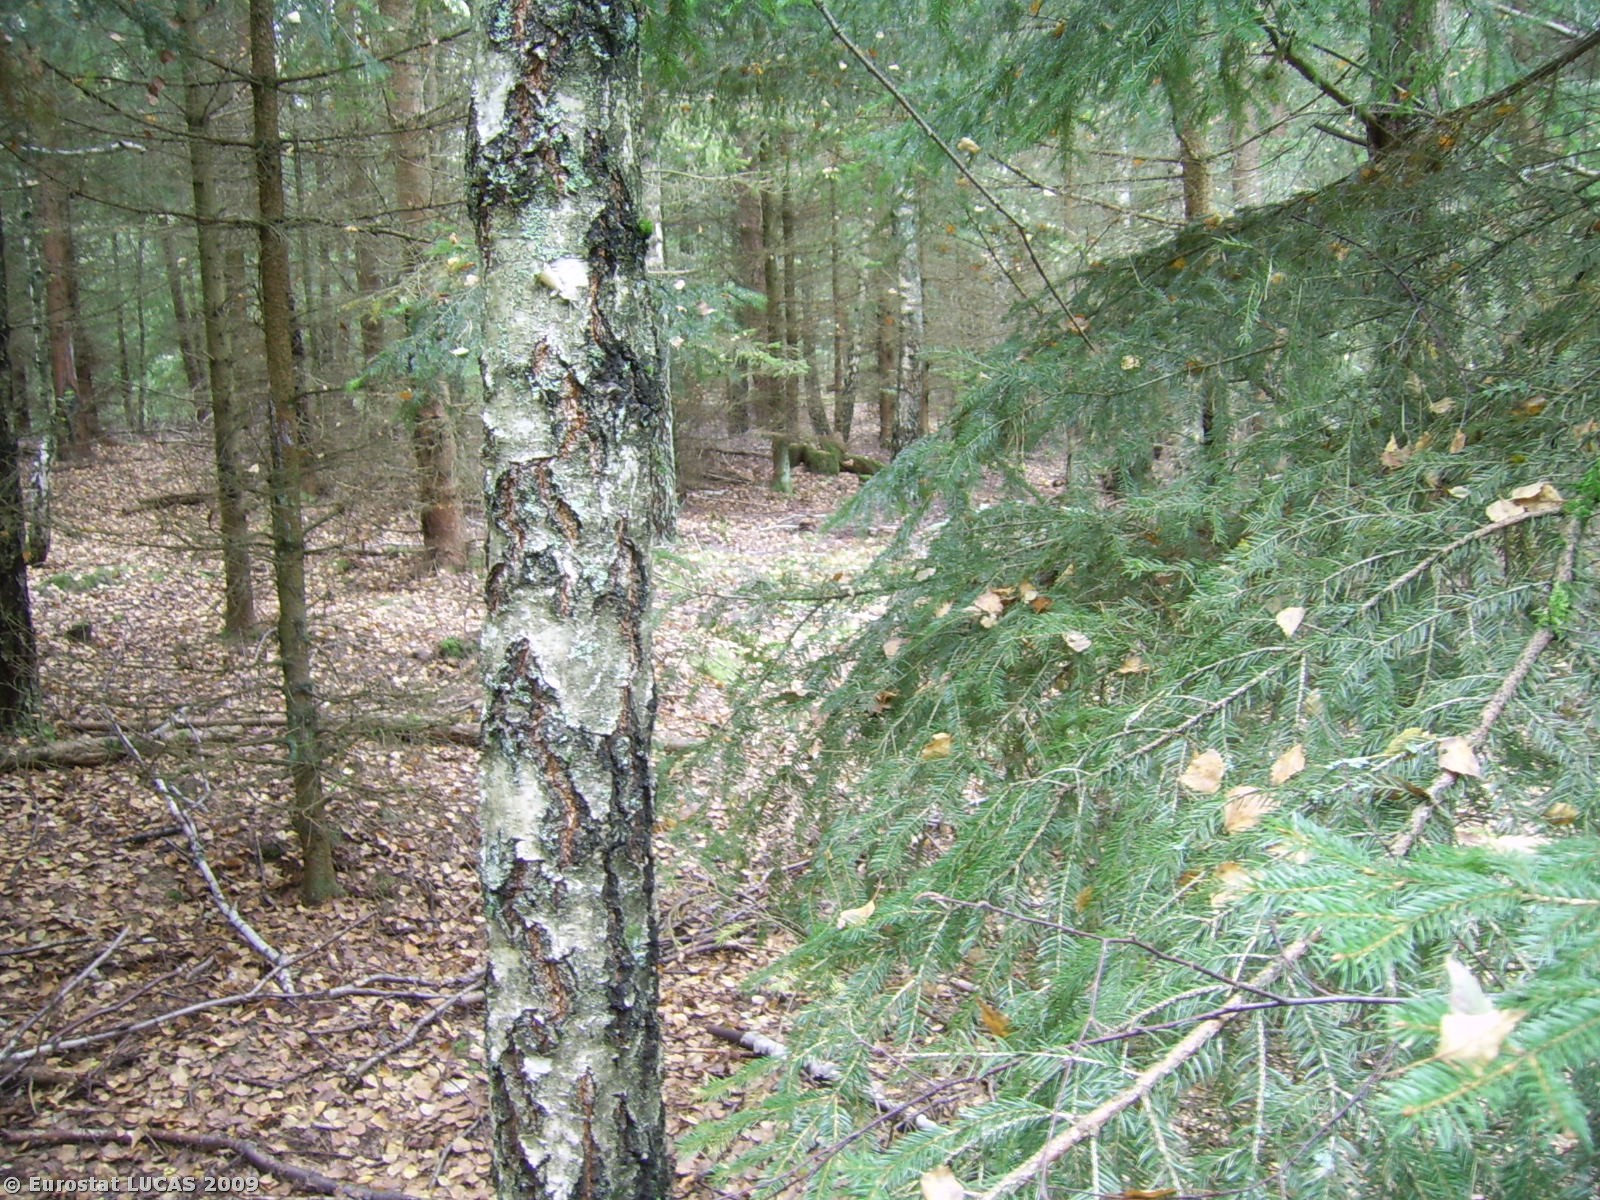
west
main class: Woodland
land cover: Mixed woodland
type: hemiboreal forest and nemoral coniferous forest and mixed broadleaved-coniferous forest
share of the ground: 50 - 75 %
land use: Forestry
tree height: > 5 m
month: September
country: PL
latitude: 54.1513
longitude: 16.4212
